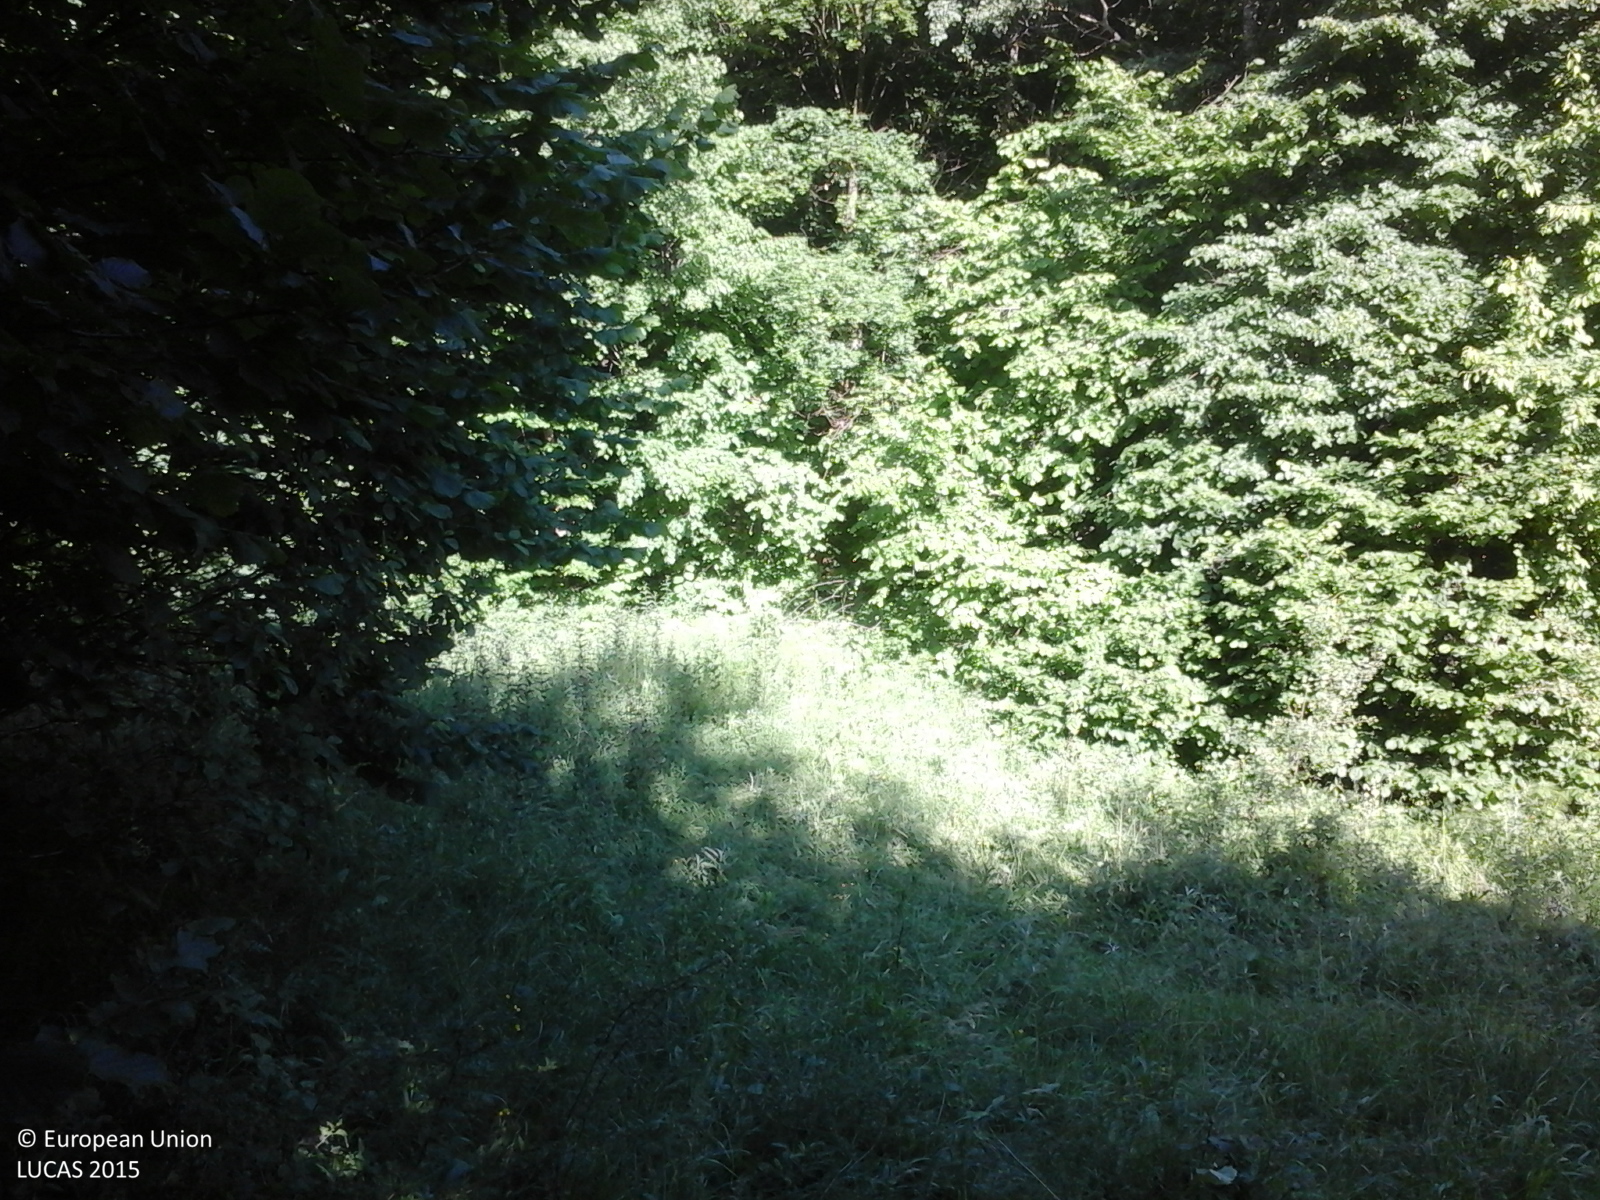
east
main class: Woodland
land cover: Broadleaved woodland
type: non-riverine alder, birch or aspen forest
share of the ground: > 75 %
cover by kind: broadleaved forest trees 100 %
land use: Forestry
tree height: > 5 m
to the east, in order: Broadleaved woodland; Grassland without tree/shrub cover; Broadleaved woodland
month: June
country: RO
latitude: 45.0884
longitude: 25.7172
